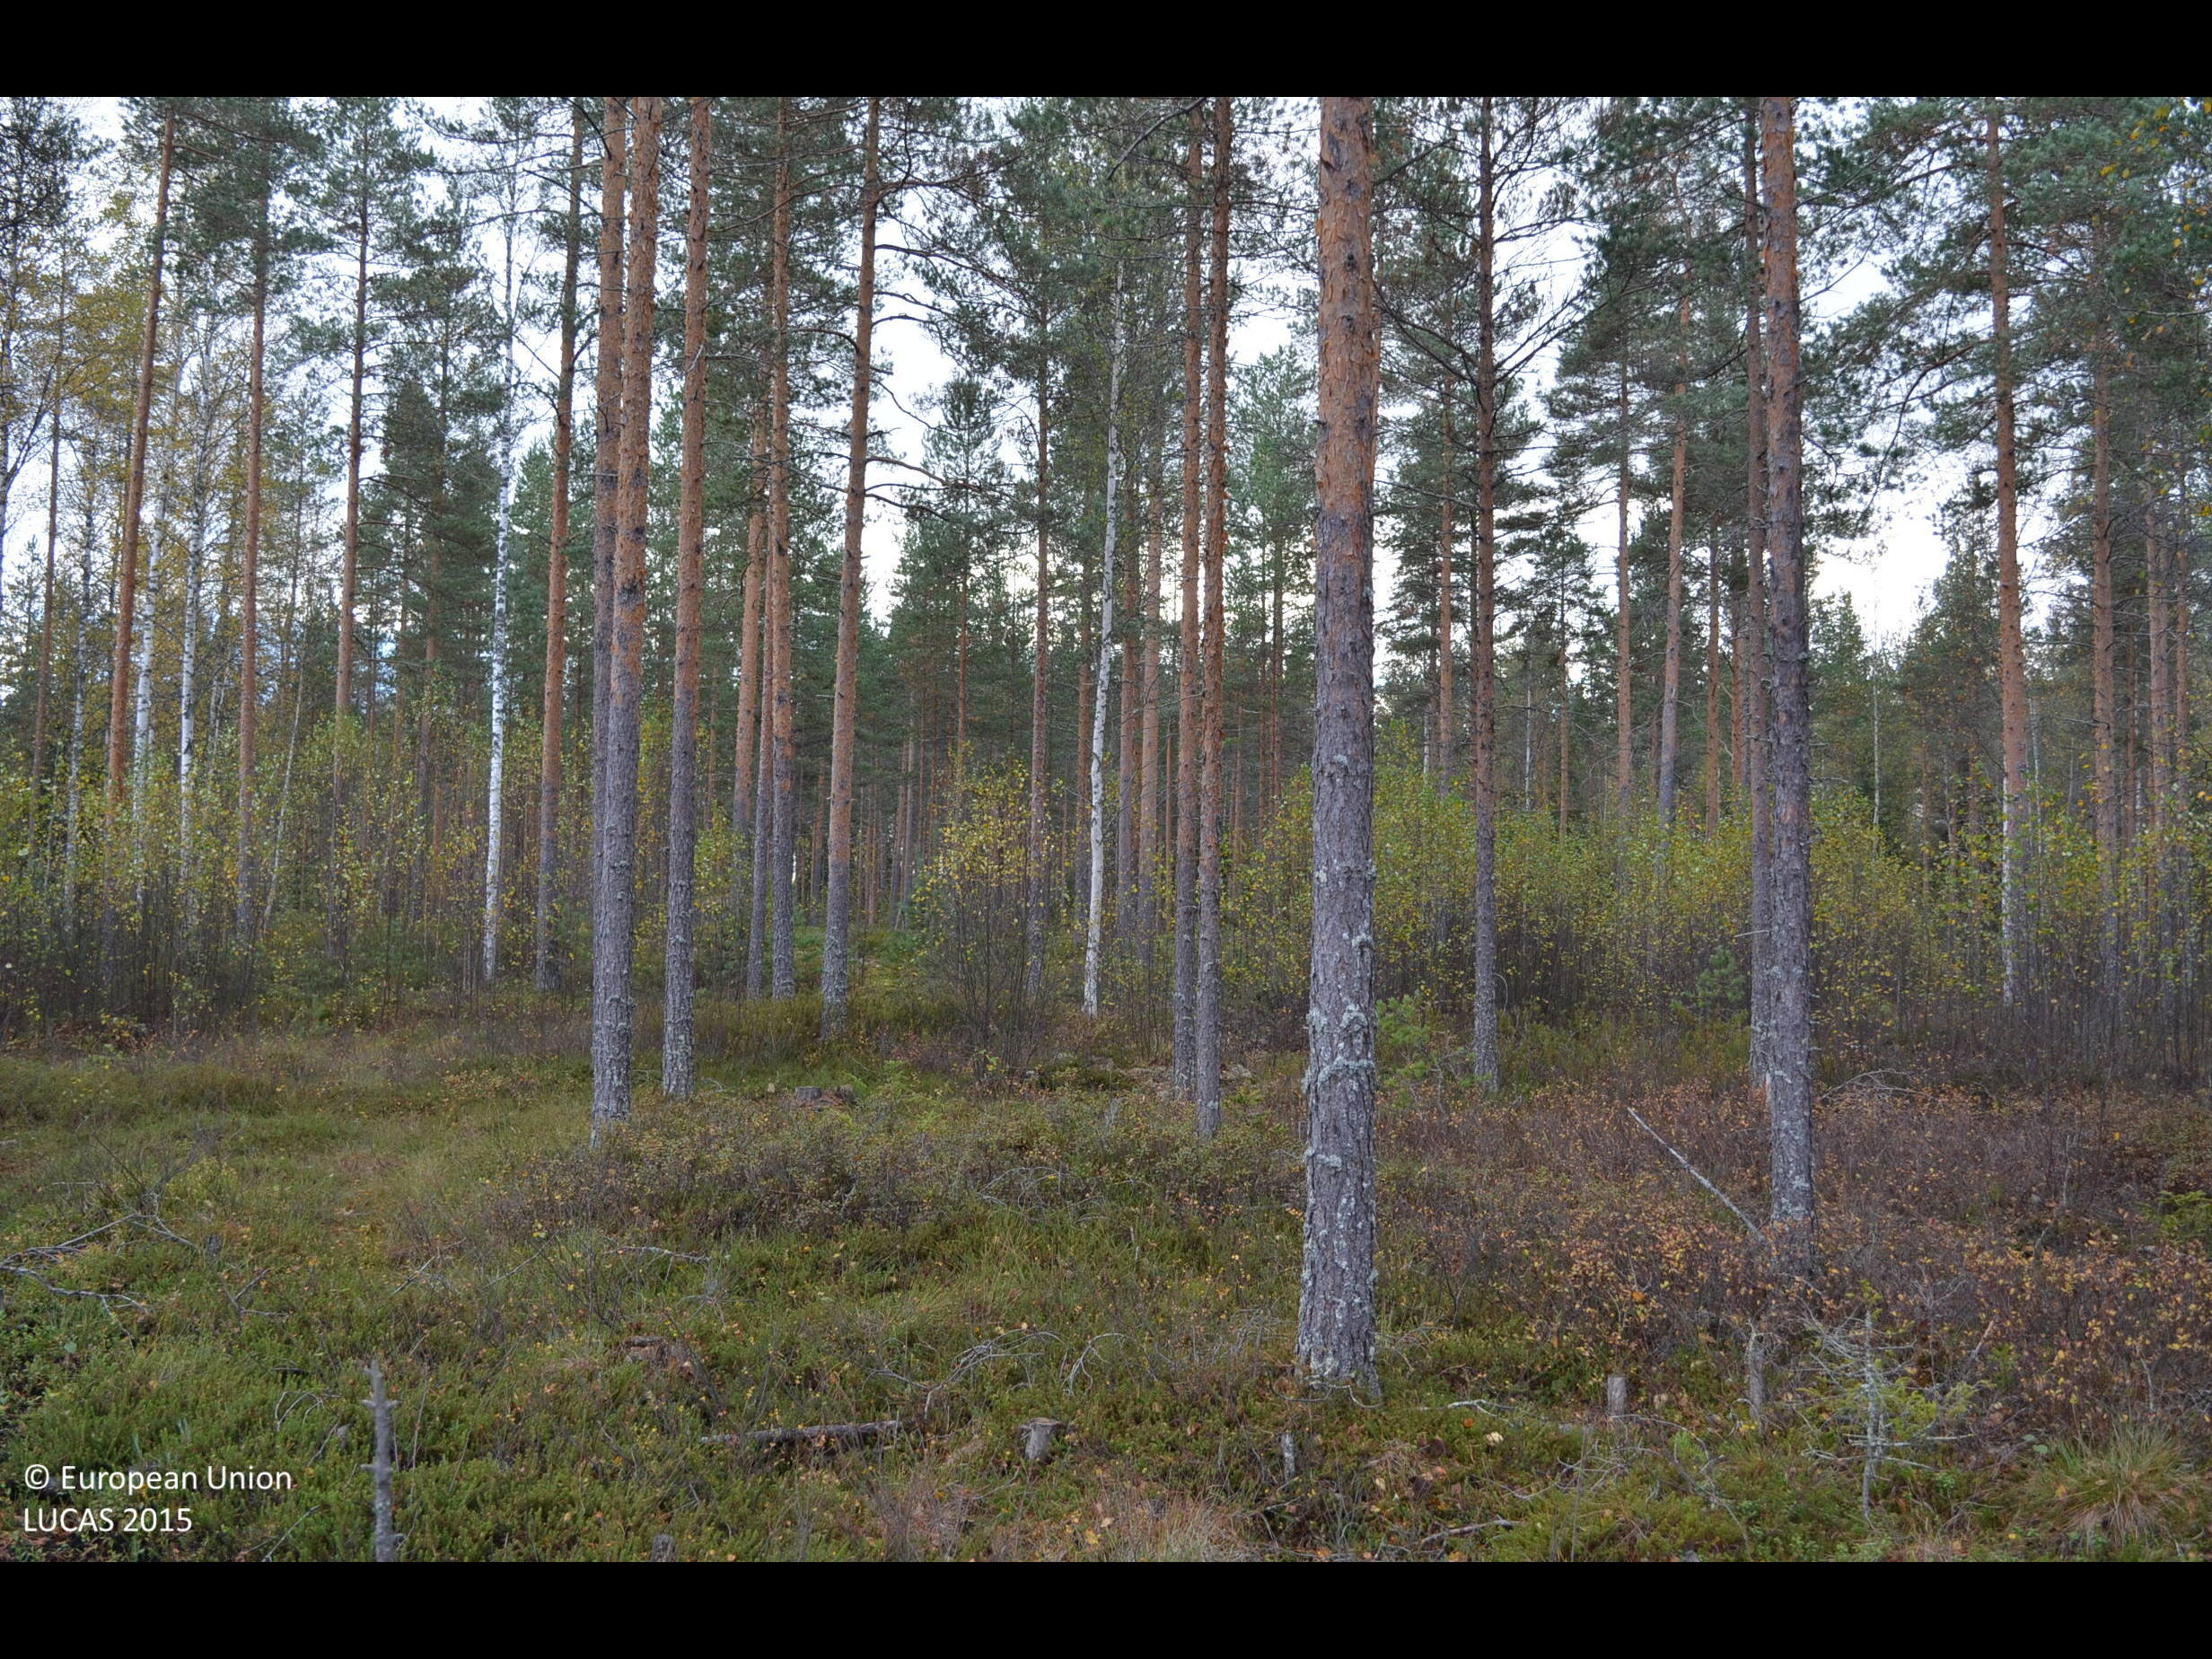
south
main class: Woodland
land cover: Pine dominated mixed woodland
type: boreal forest
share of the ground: 50 - 75 %
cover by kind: coniferous forest trees 40 %, broadleaved forest trees 30 %, shrubs 30 %
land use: Forestry
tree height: > 5 m
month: September
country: FI
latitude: 62.4906
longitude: 23.5597
